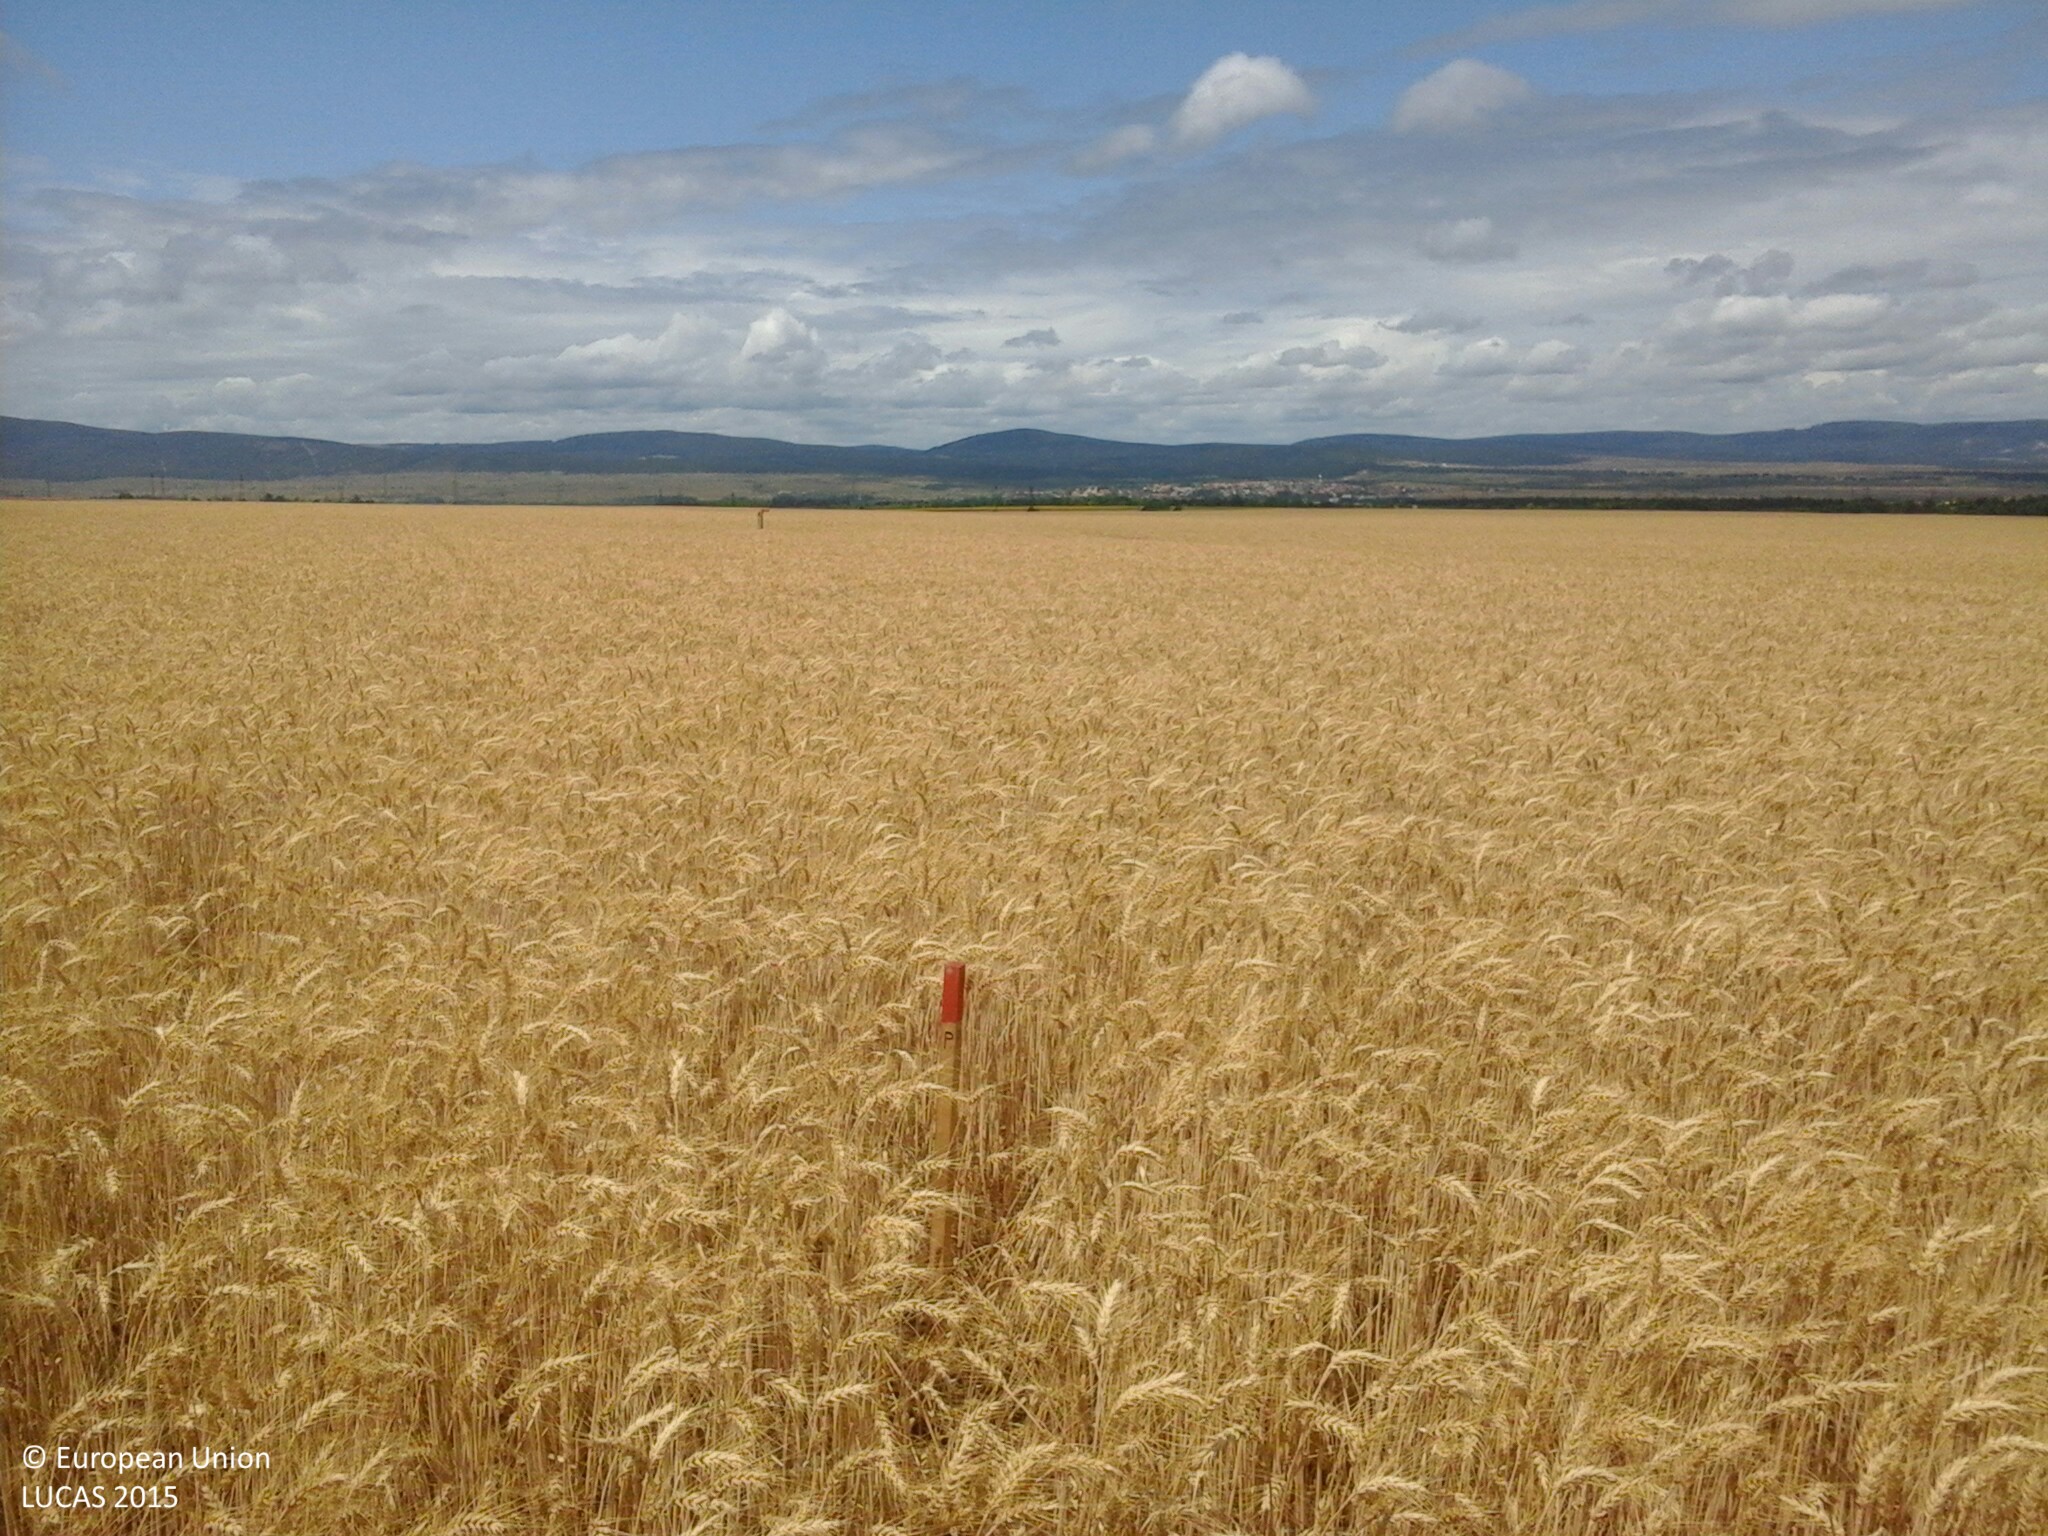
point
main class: Cropland
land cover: Durum wheat
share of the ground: > 75 %
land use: Agriculture (excluding fallow land and kitchen gardens)
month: July
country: HU
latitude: 47.0861
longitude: 17.9520
